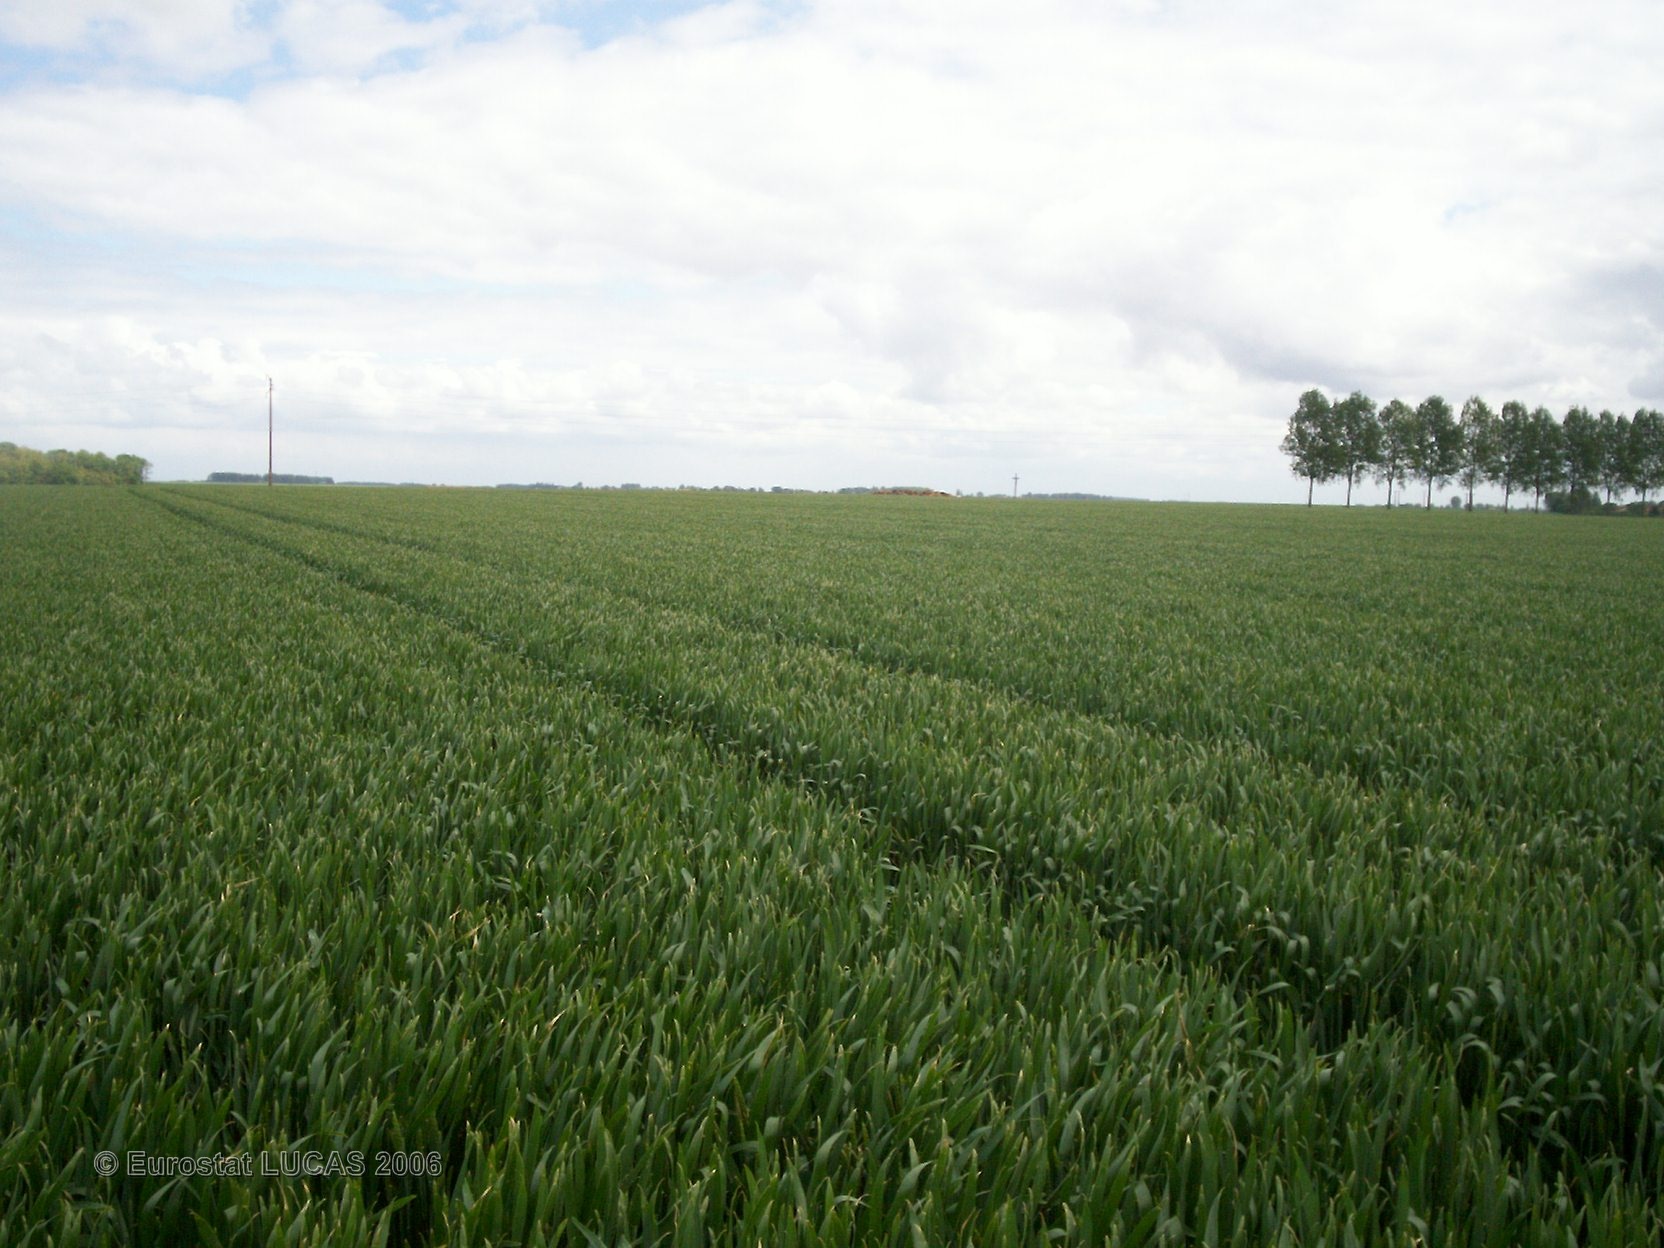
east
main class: Cropland
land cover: Common wheat
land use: Agriculture (excluding fallow land and kitchen gardens)
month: May
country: FR
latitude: 49.8571
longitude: 2.6581
